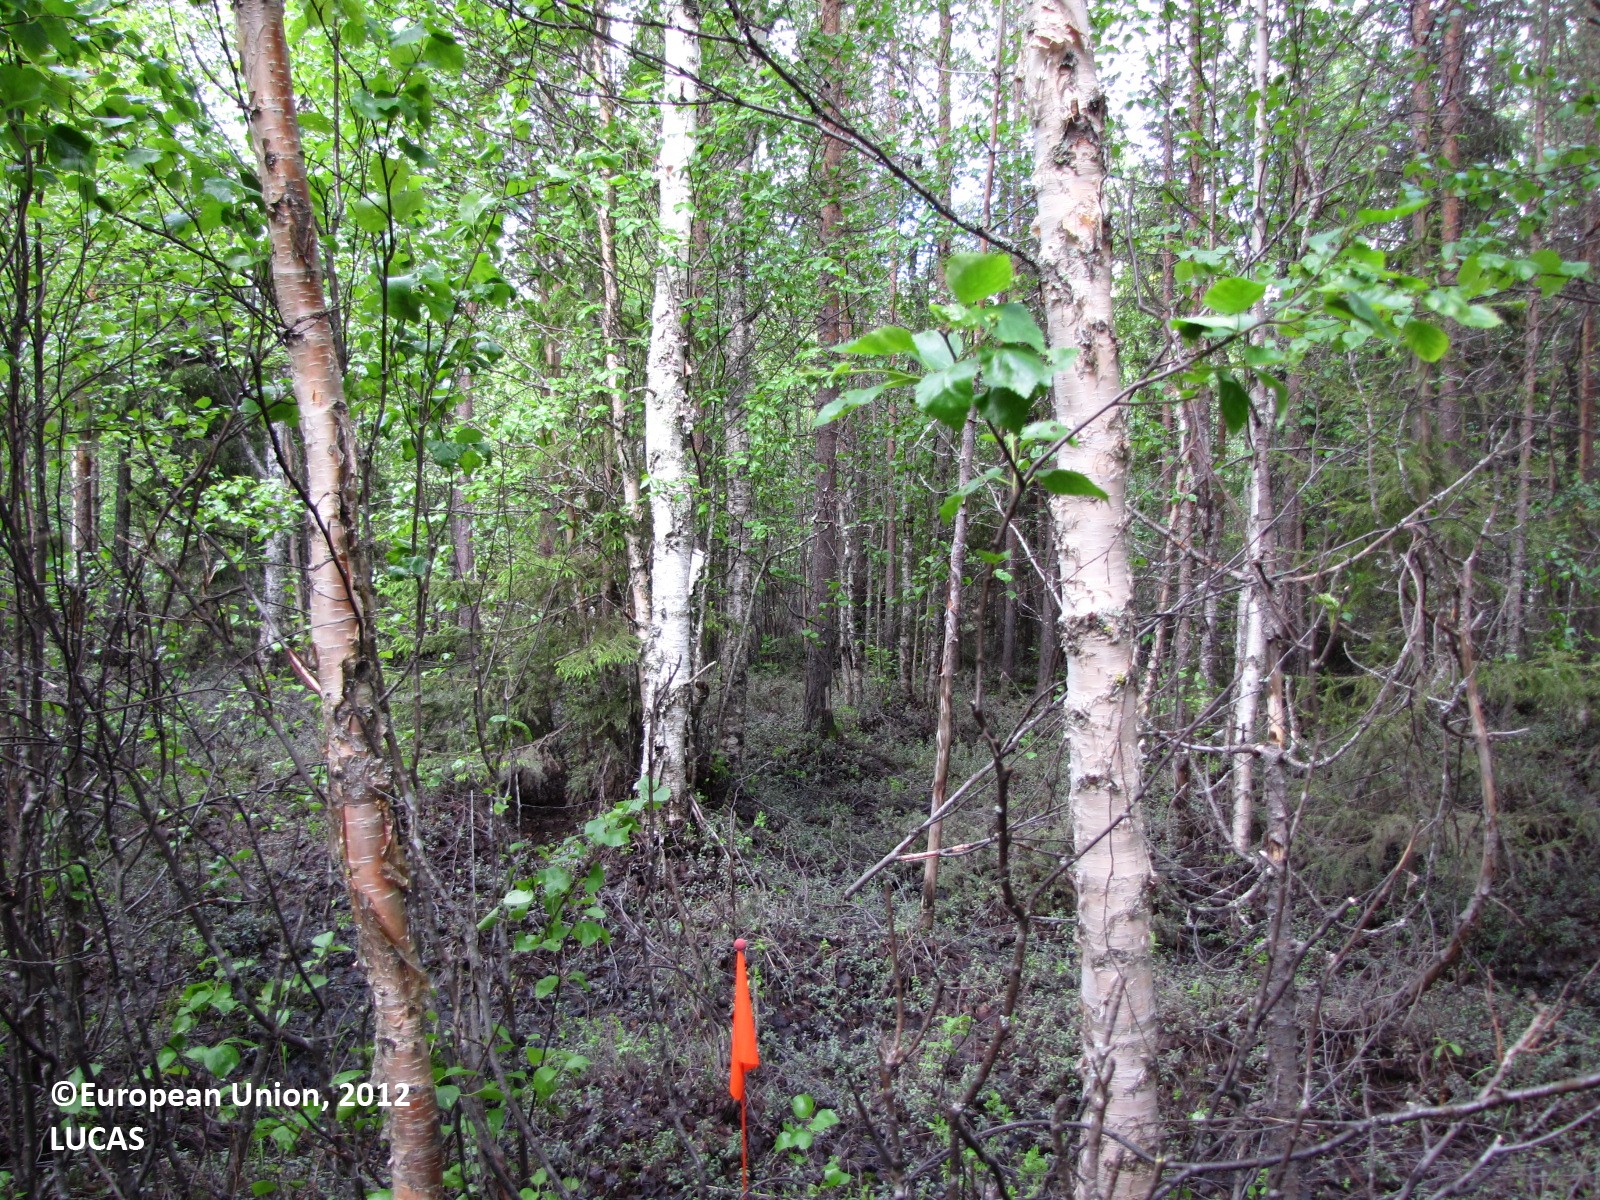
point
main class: Woodland
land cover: Pine dominated mixed woodland
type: boreal forest
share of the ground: 50 - 75 %
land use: Forestry
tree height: > 5 m
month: June
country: FI
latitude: 66.4723
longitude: 24.3423
